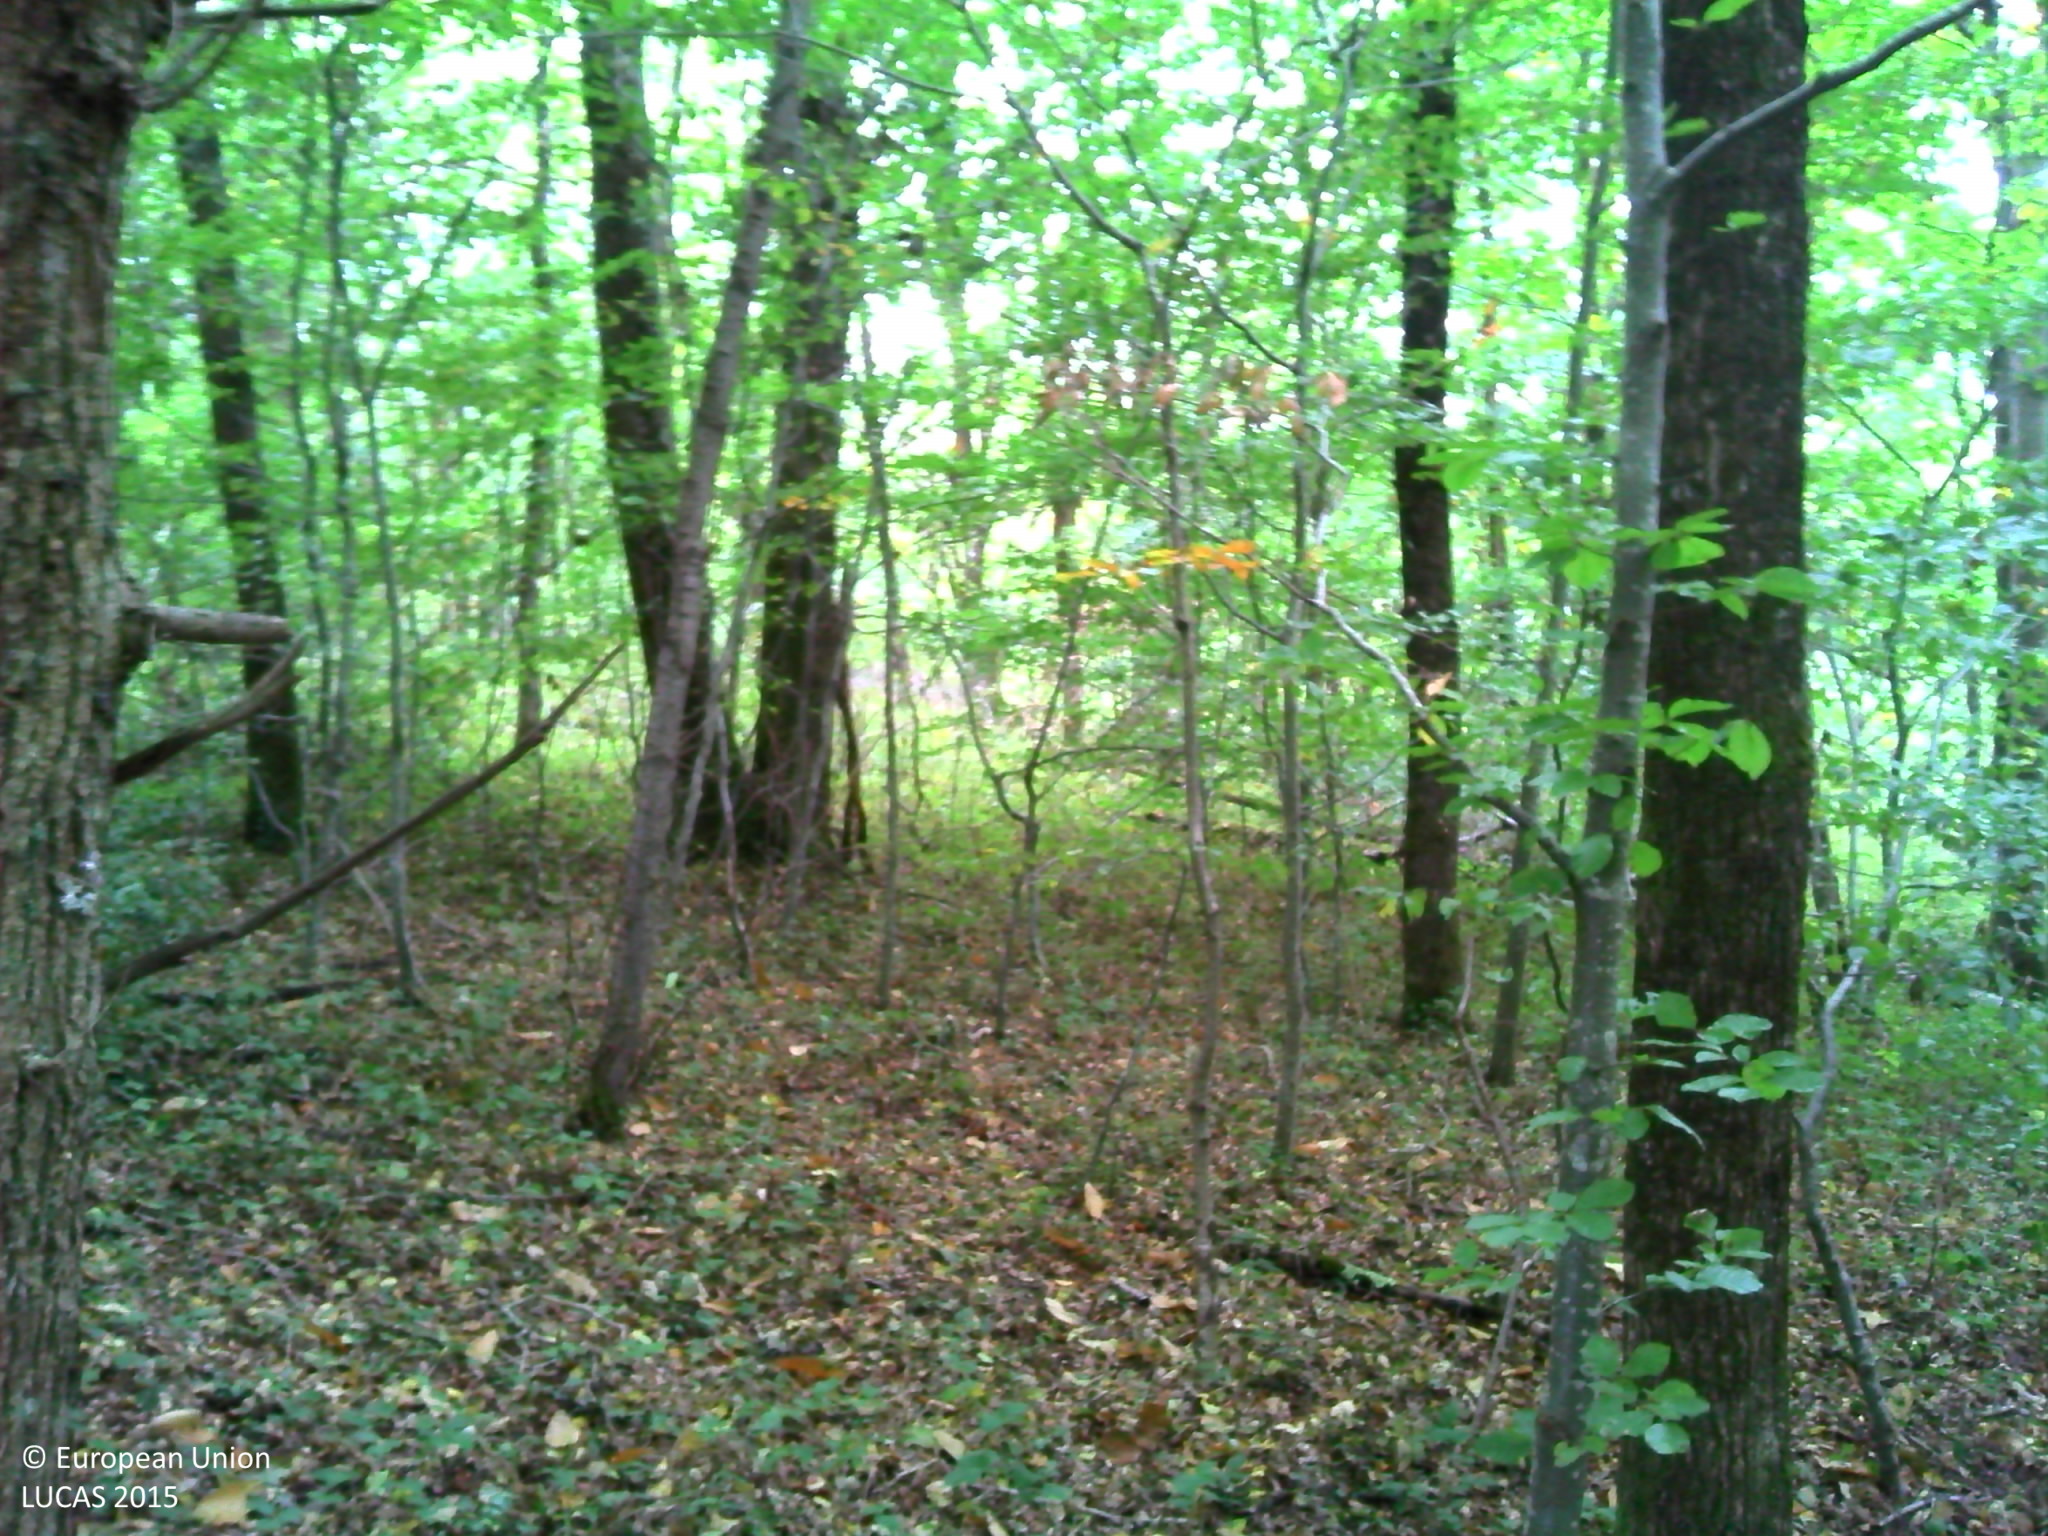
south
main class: Woodland
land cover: Broadleaved woodland
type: mesophytic deciduous forest
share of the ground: > 75 %
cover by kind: broadleaved forest trees 85 %, unconsolidated bare surface 10 %, herbaceous plants 5 %
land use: Forestry
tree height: > 5 m
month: September
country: FR
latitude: 46.4206
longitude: 1.6245
